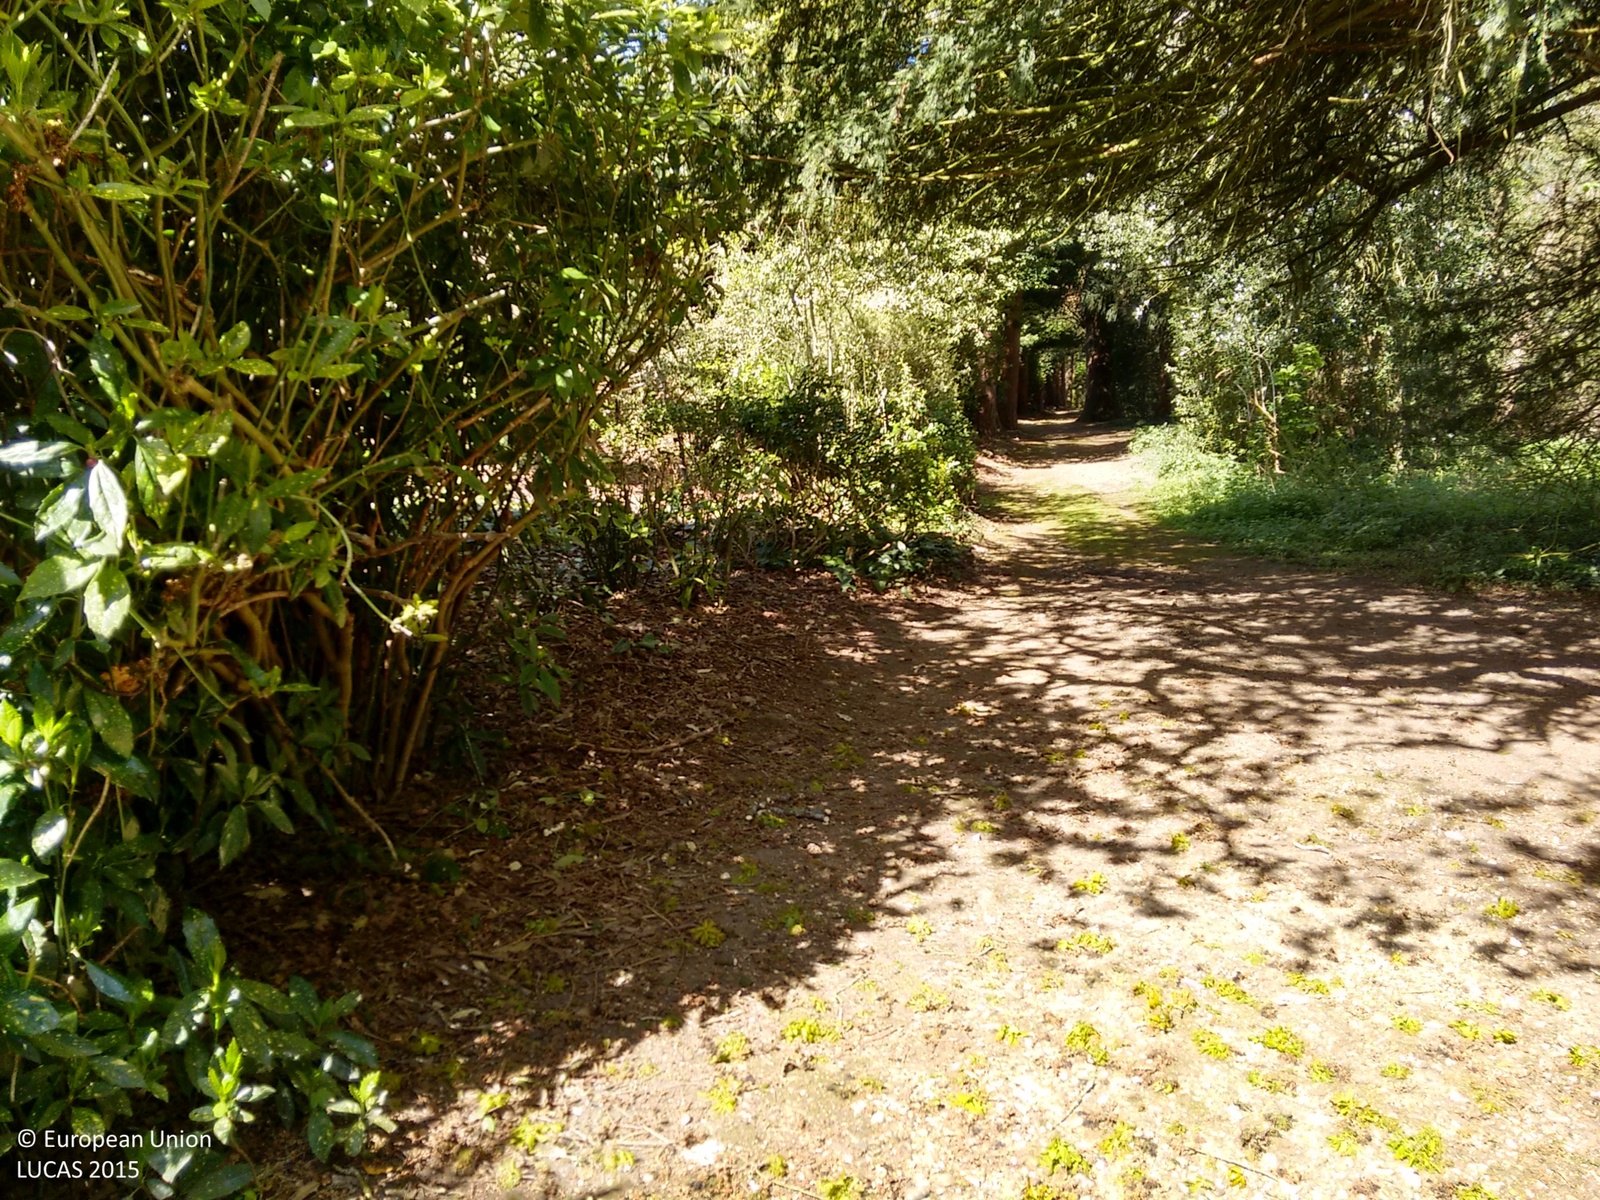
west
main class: Grassland
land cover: Grassland with sparse tree/shrub cover
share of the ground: > 75 %
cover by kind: herbaceous plants 95 %, broadleaved forest trees 5 %
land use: Residential
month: April
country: GB
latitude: 51.1470
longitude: -1.4725
